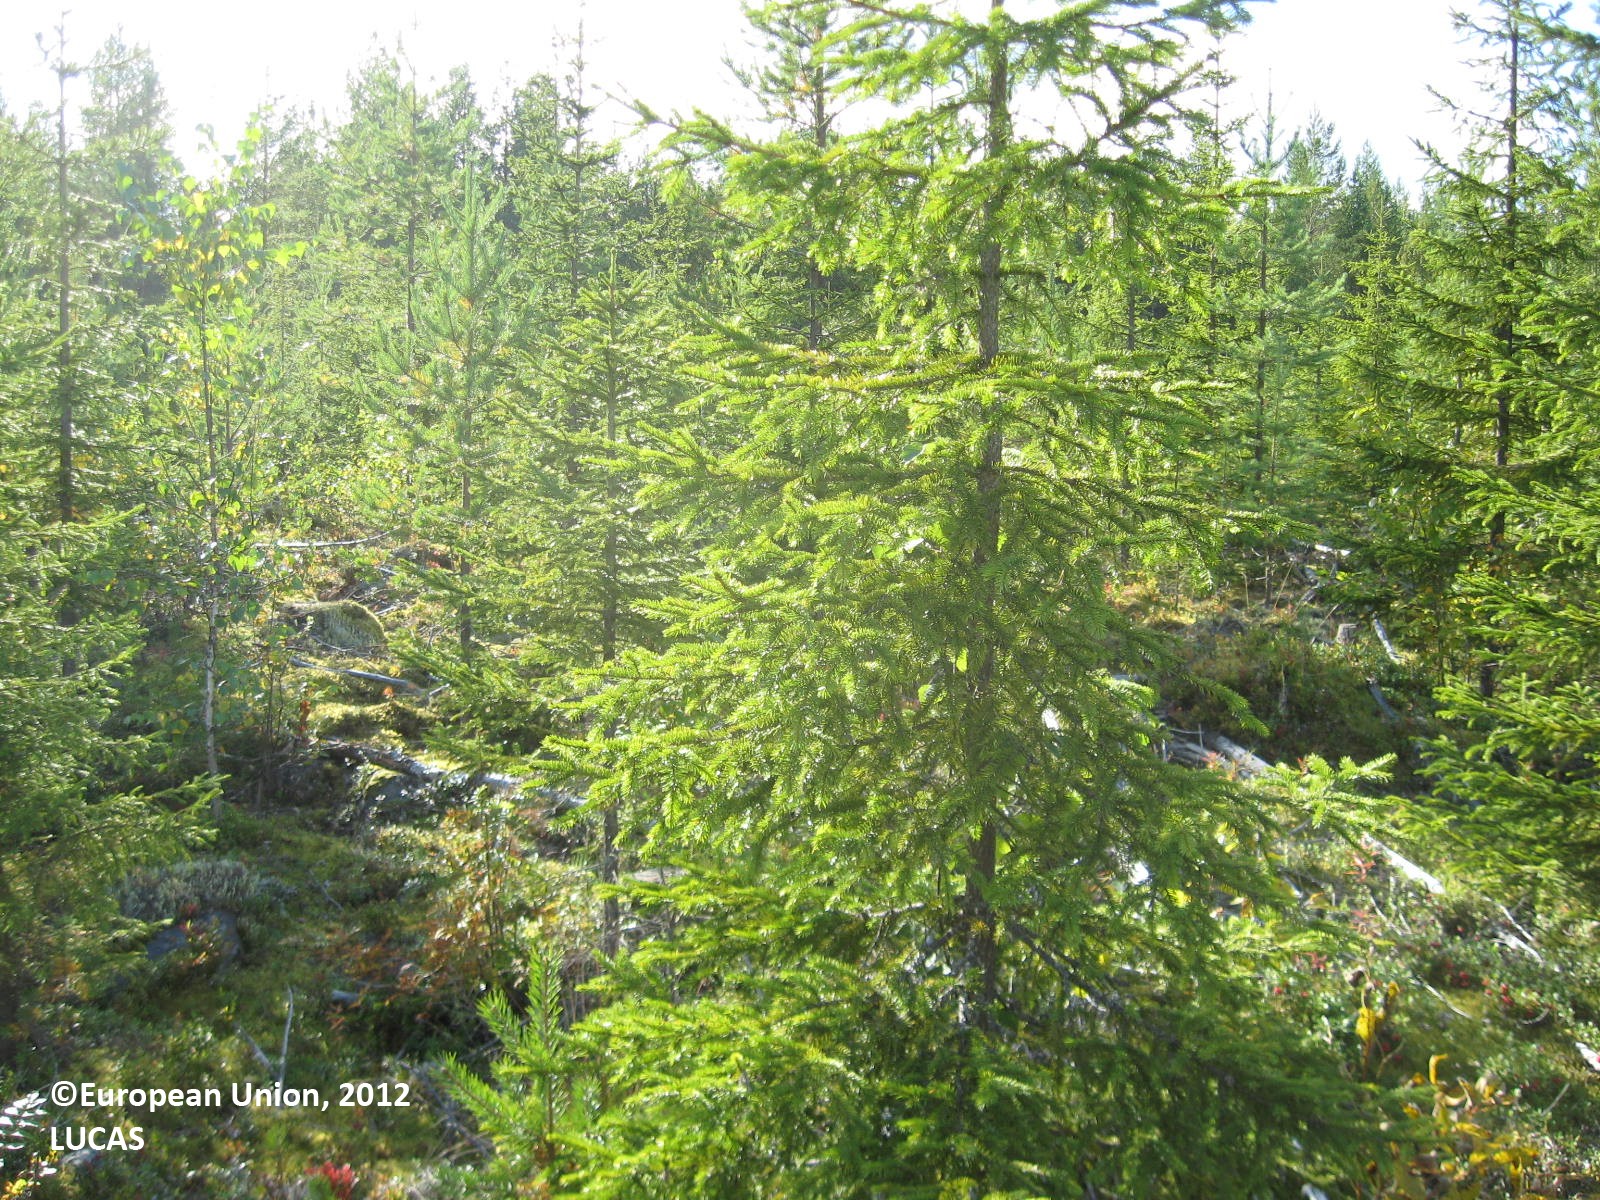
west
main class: Woodland
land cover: Spruce dominated coniferous woodland
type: boreal forest
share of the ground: > 75 %
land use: Forestry
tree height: < 5 m
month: August
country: FI
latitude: 63.9547
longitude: 29.9374
